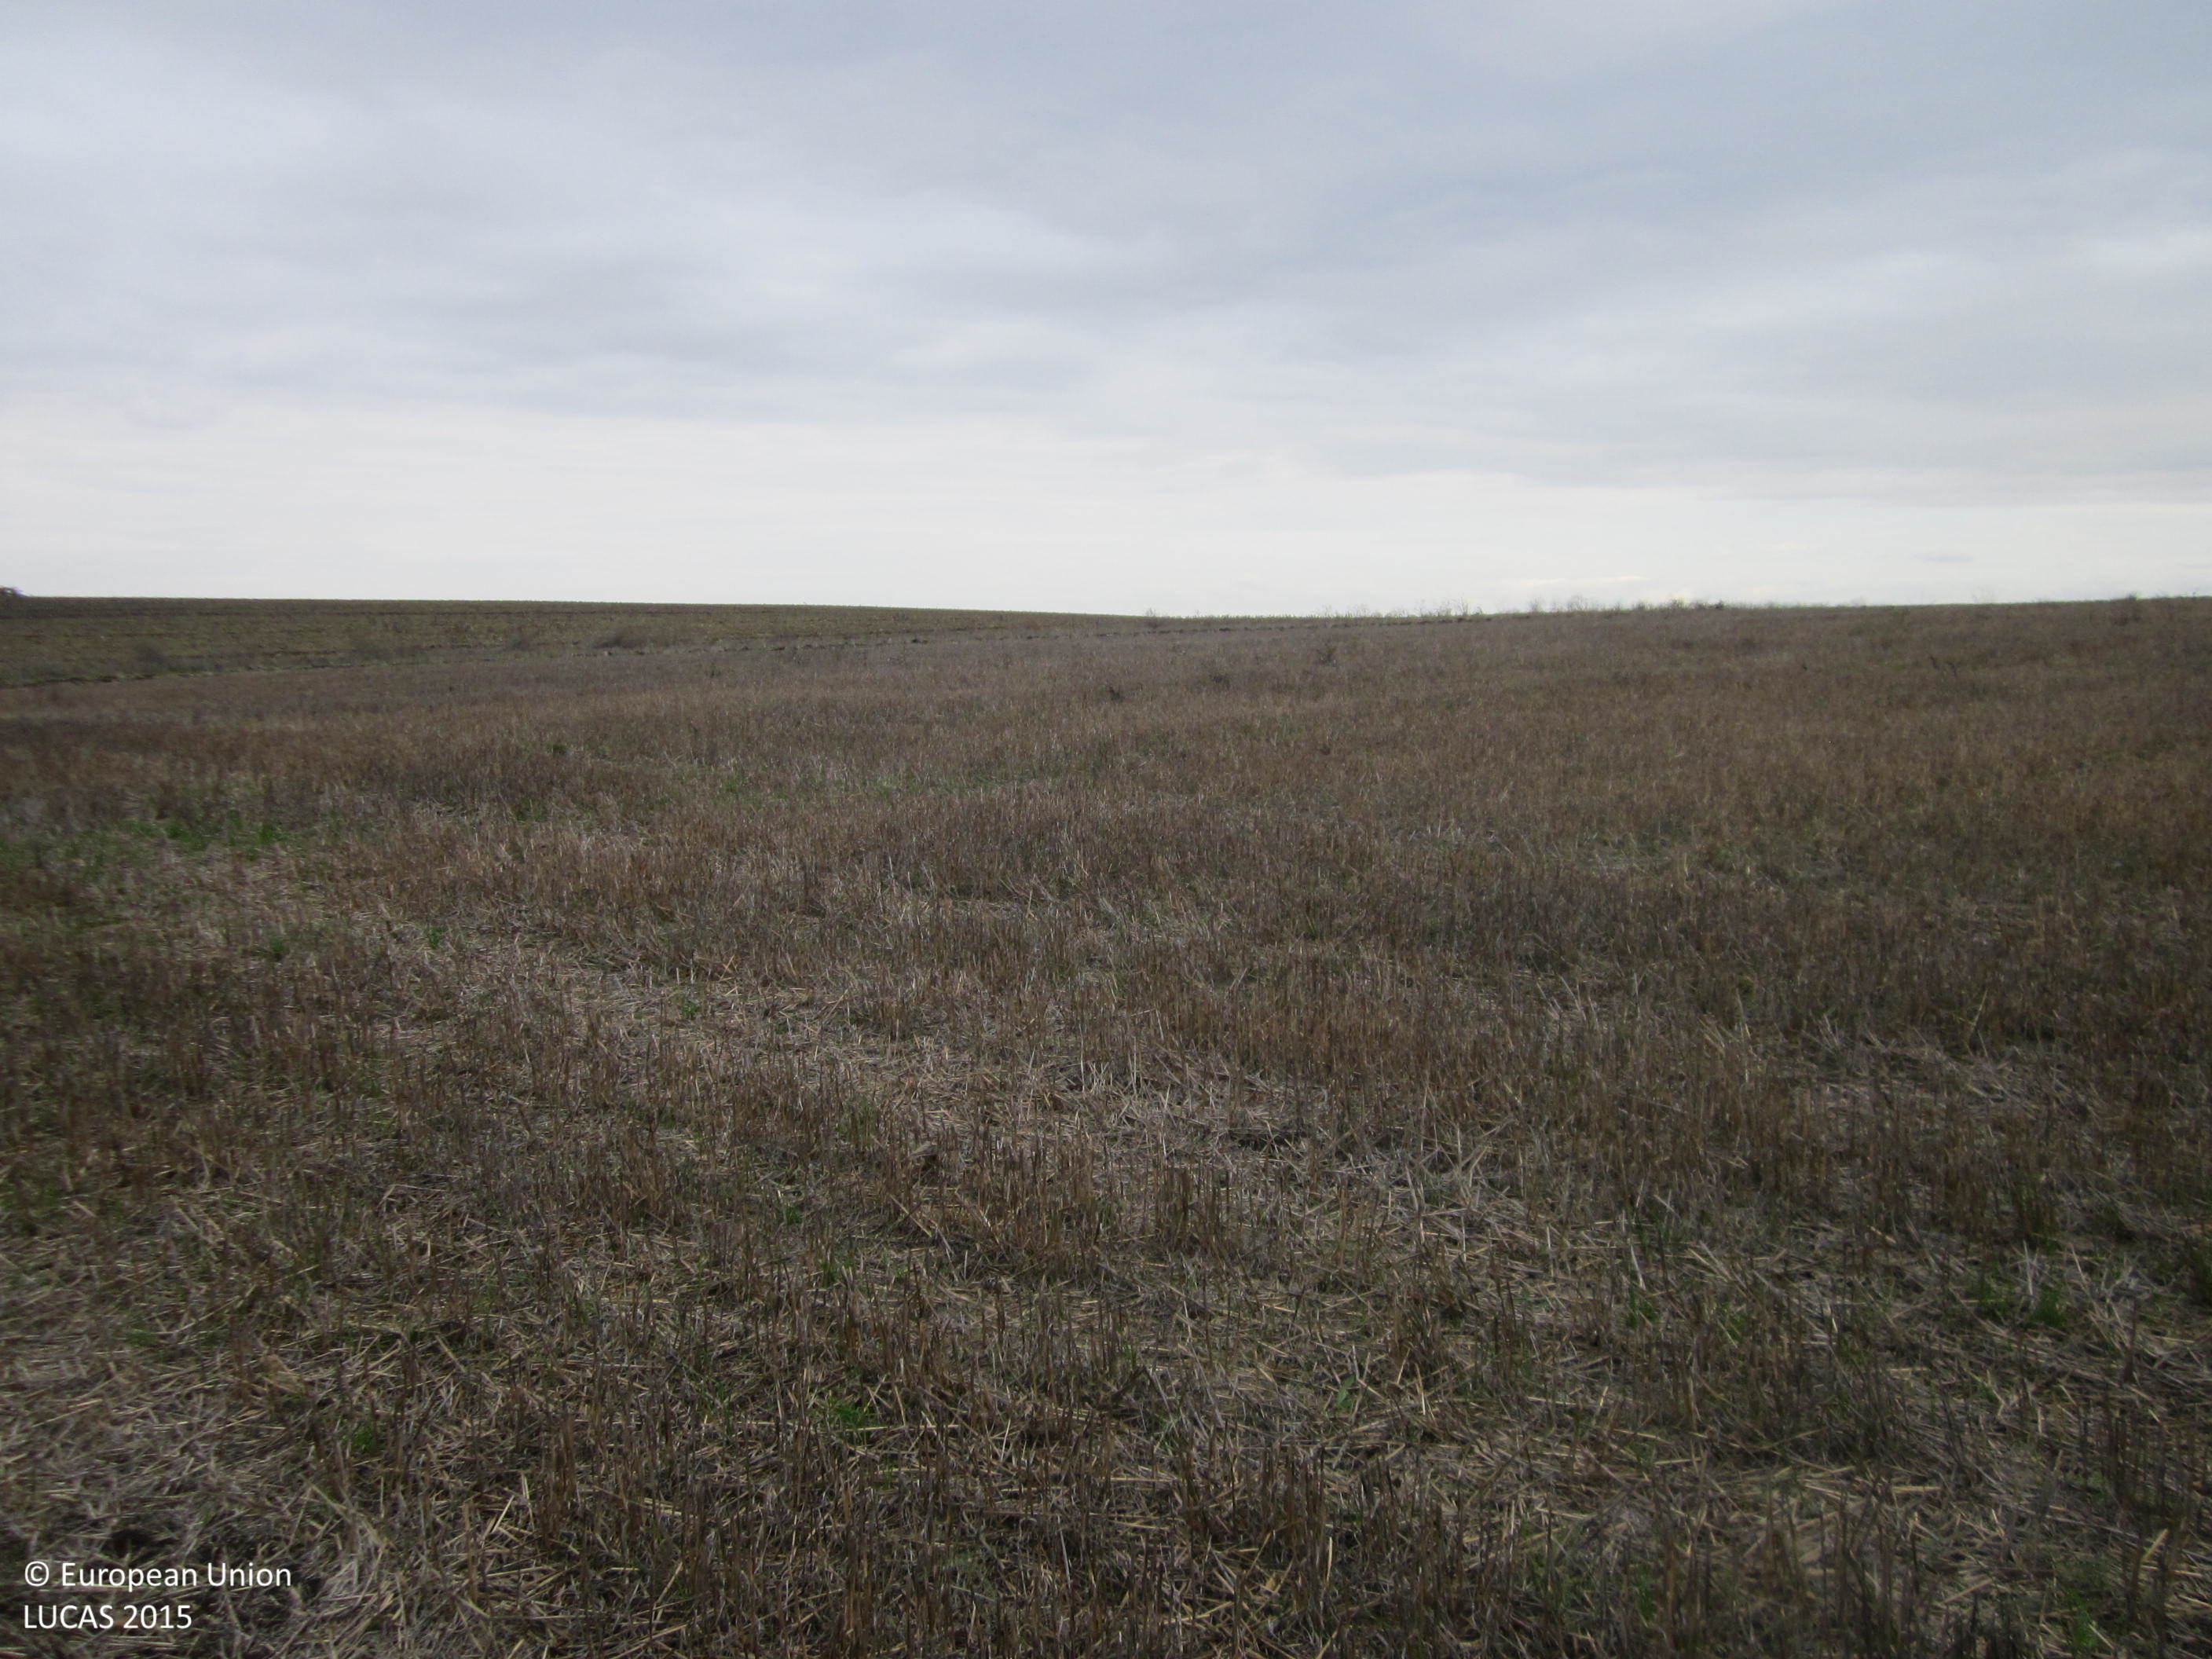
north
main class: Cropland
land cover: Common wheat
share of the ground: 25 - 50 %
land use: Agriculture (excluding fallow land and kitchen gardens)
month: October
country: BG
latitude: 42.3820
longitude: 26.8980
